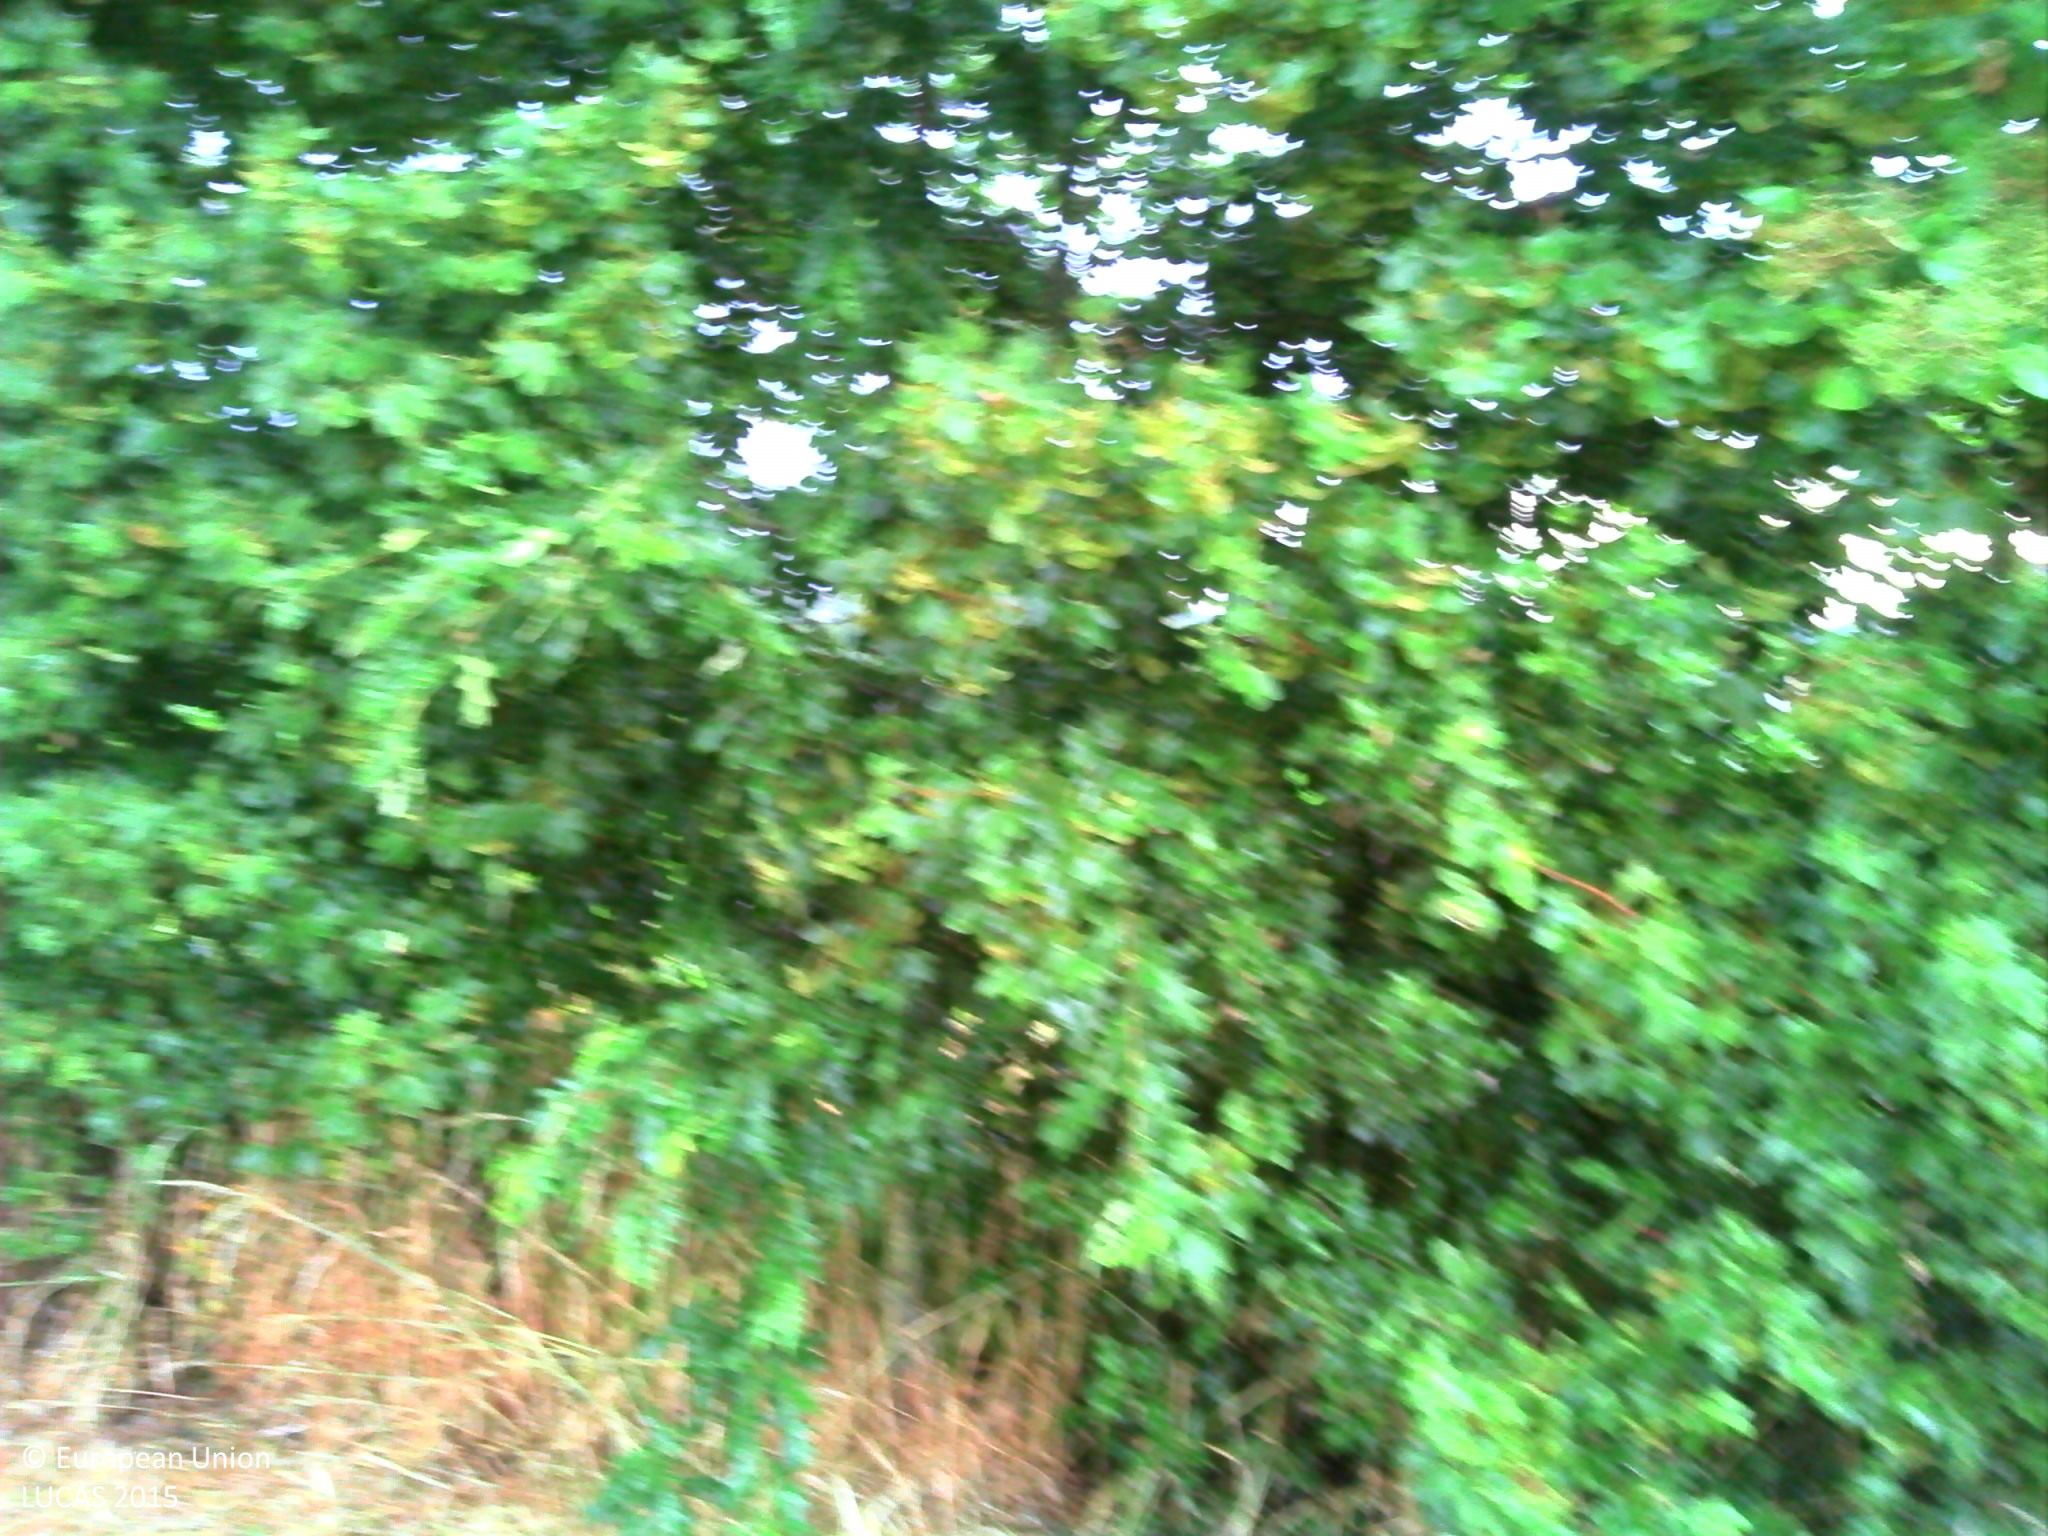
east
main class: Cropland
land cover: Barley
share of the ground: > 75 %
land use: Agriculture (excluding fallow land and kitchen gardens)
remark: Tilled/Sowed
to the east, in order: Barley; Abandoned hedges; Maize; Ditches and canals; Electric lines; Grass margins; Paved roads, cycling and walking lanes; Grass margins; Ditches and canals; Fences; Grassland without tree/shrub cover; Fences; Electric lines; Grass margins; Paved roads, cycling and walking lanes; Grassland without tree/shrub cover; Abandoned hedges; Fences; Grassland without tree/shrub cover; Electric lines; Grassland without tree/shrub cover; Artificial constructions in urban areas
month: July
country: FR
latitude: 47.9558
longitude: -1.4129
